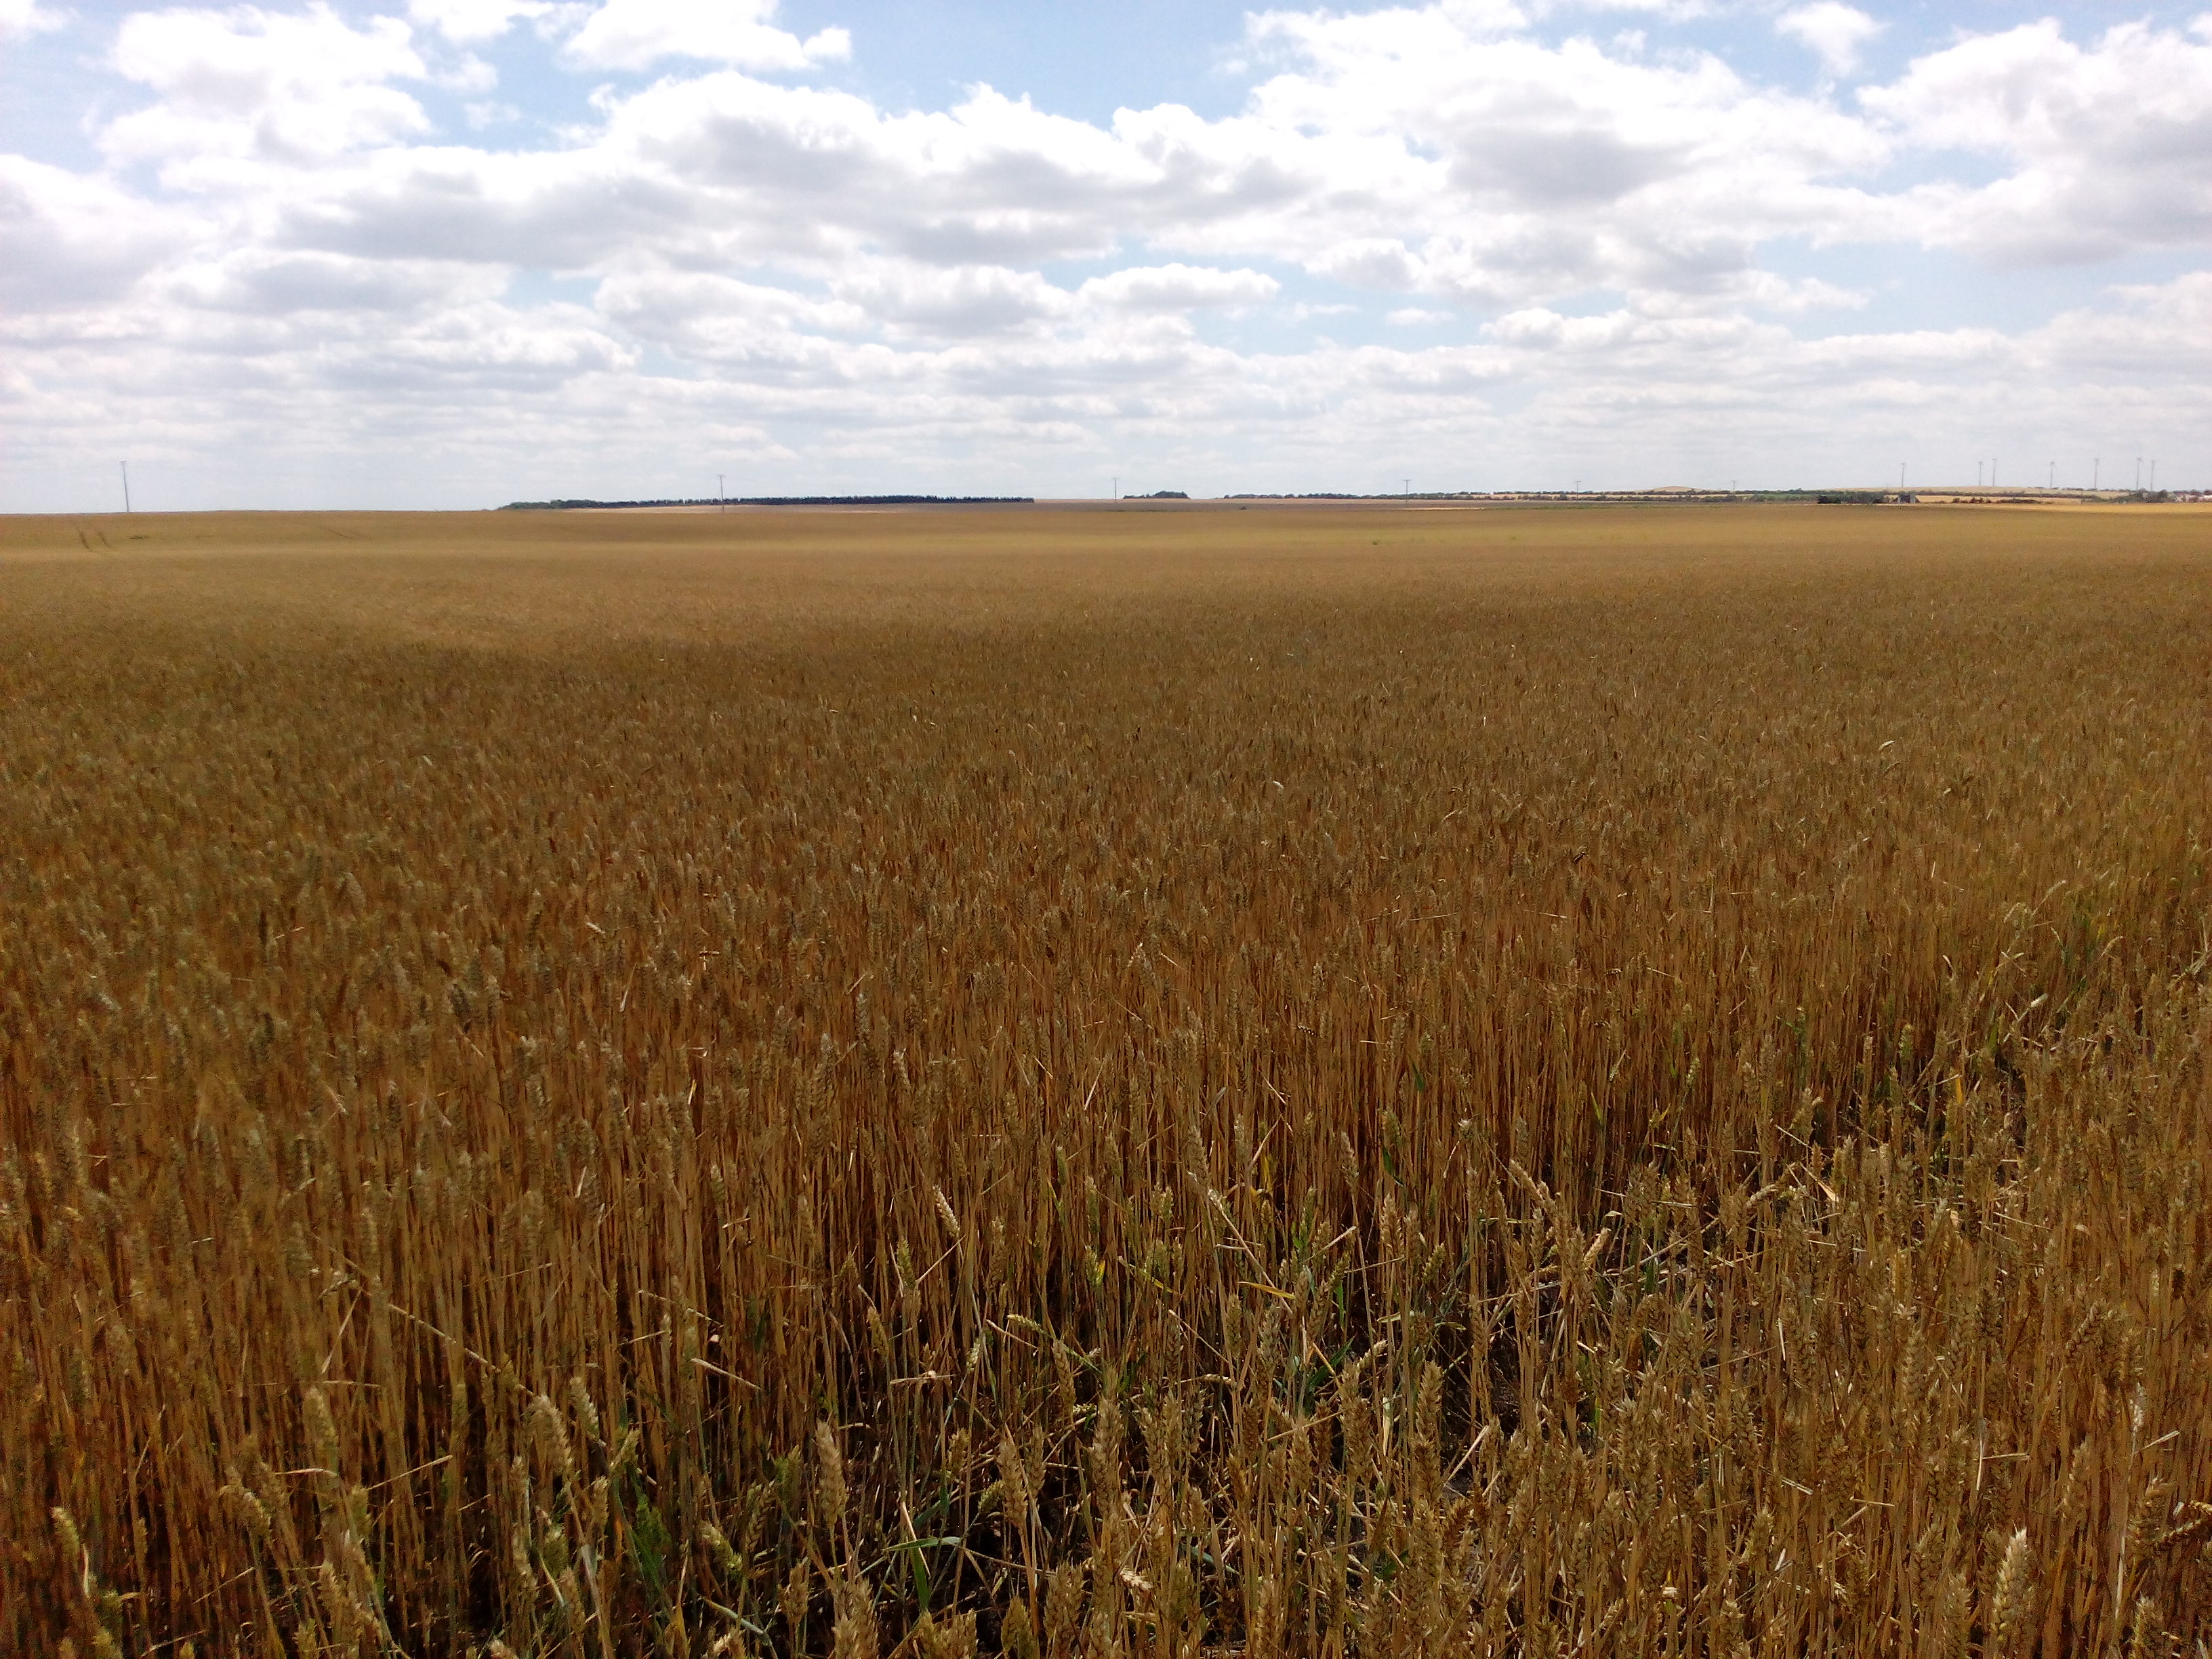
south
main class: Cropland
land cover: Common wheat
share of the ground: > 75 %
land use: Agriculture (excluding fallow land and kitchen gardens)
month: July
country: DE
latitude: 51.2038
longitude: 11.1018
